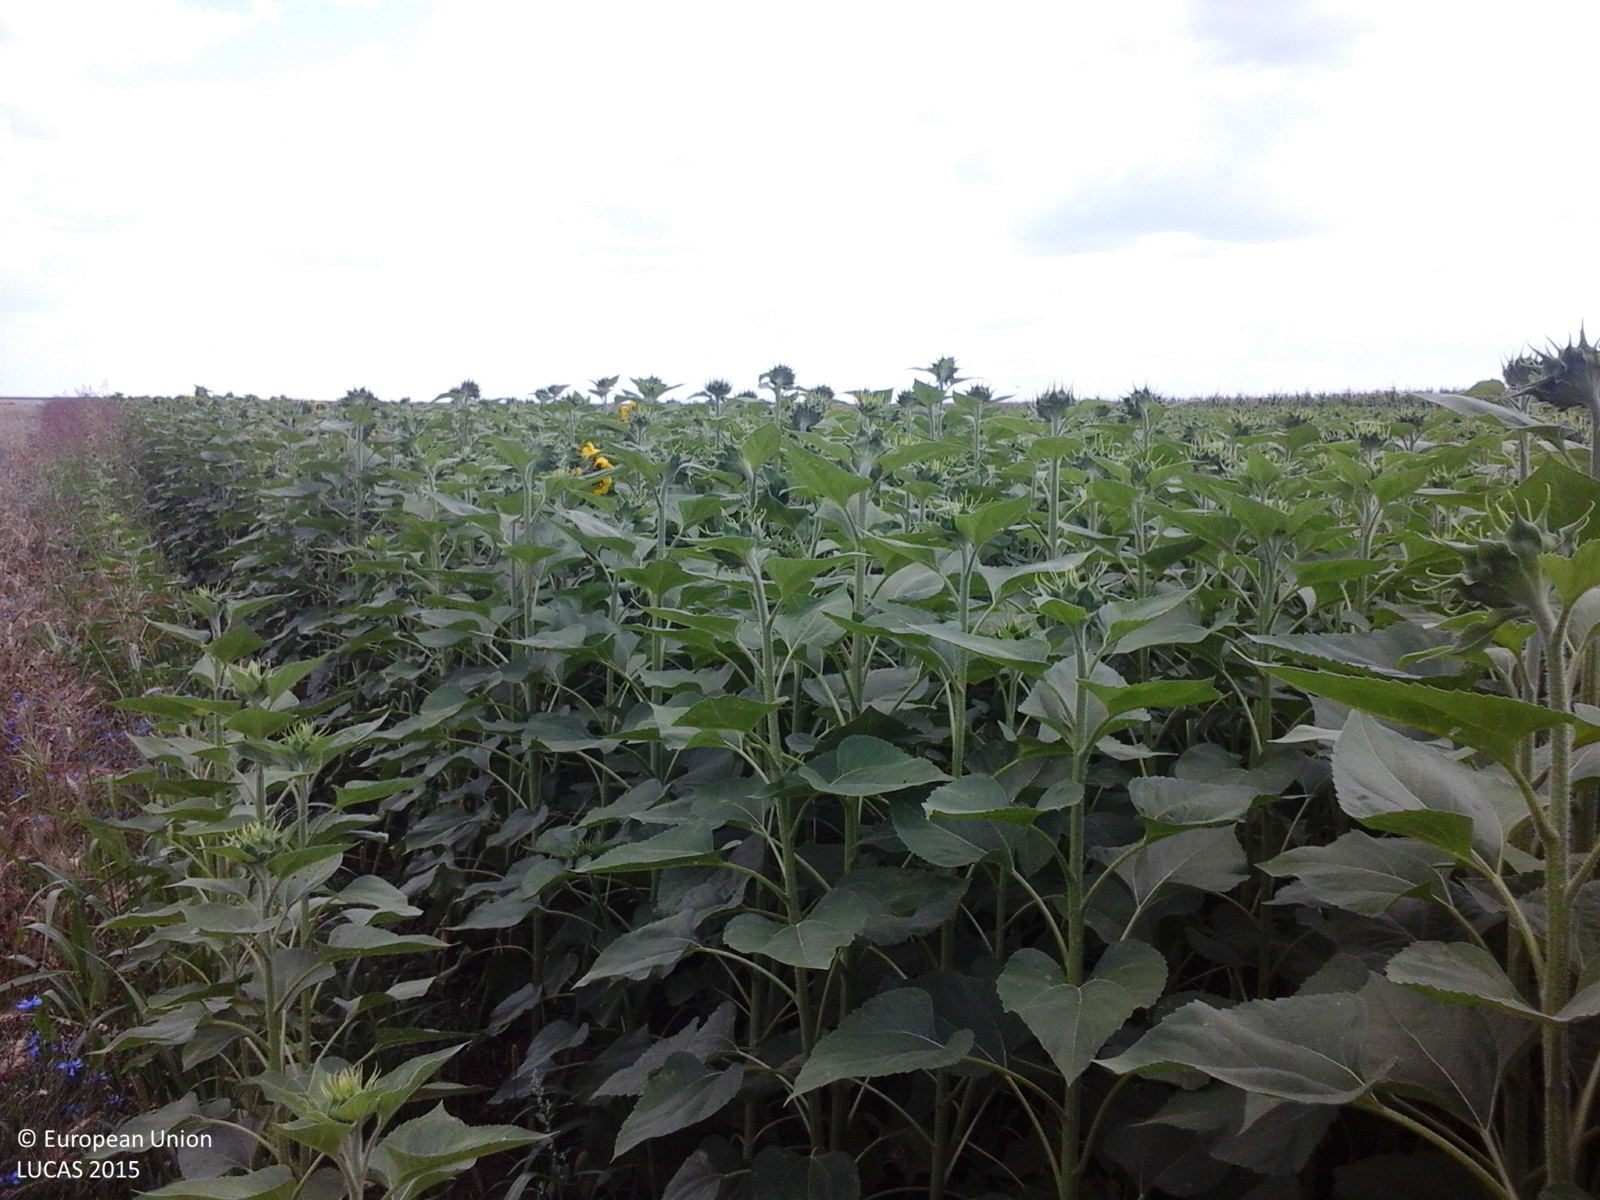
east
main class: Cropland
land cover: Sunflower
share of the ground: > 75 %
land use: Agriculture (excluding fallow land and kitchen gardens)
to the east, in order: Sunflower
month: July
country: RO
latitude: 43.9755
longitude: 24.6922
